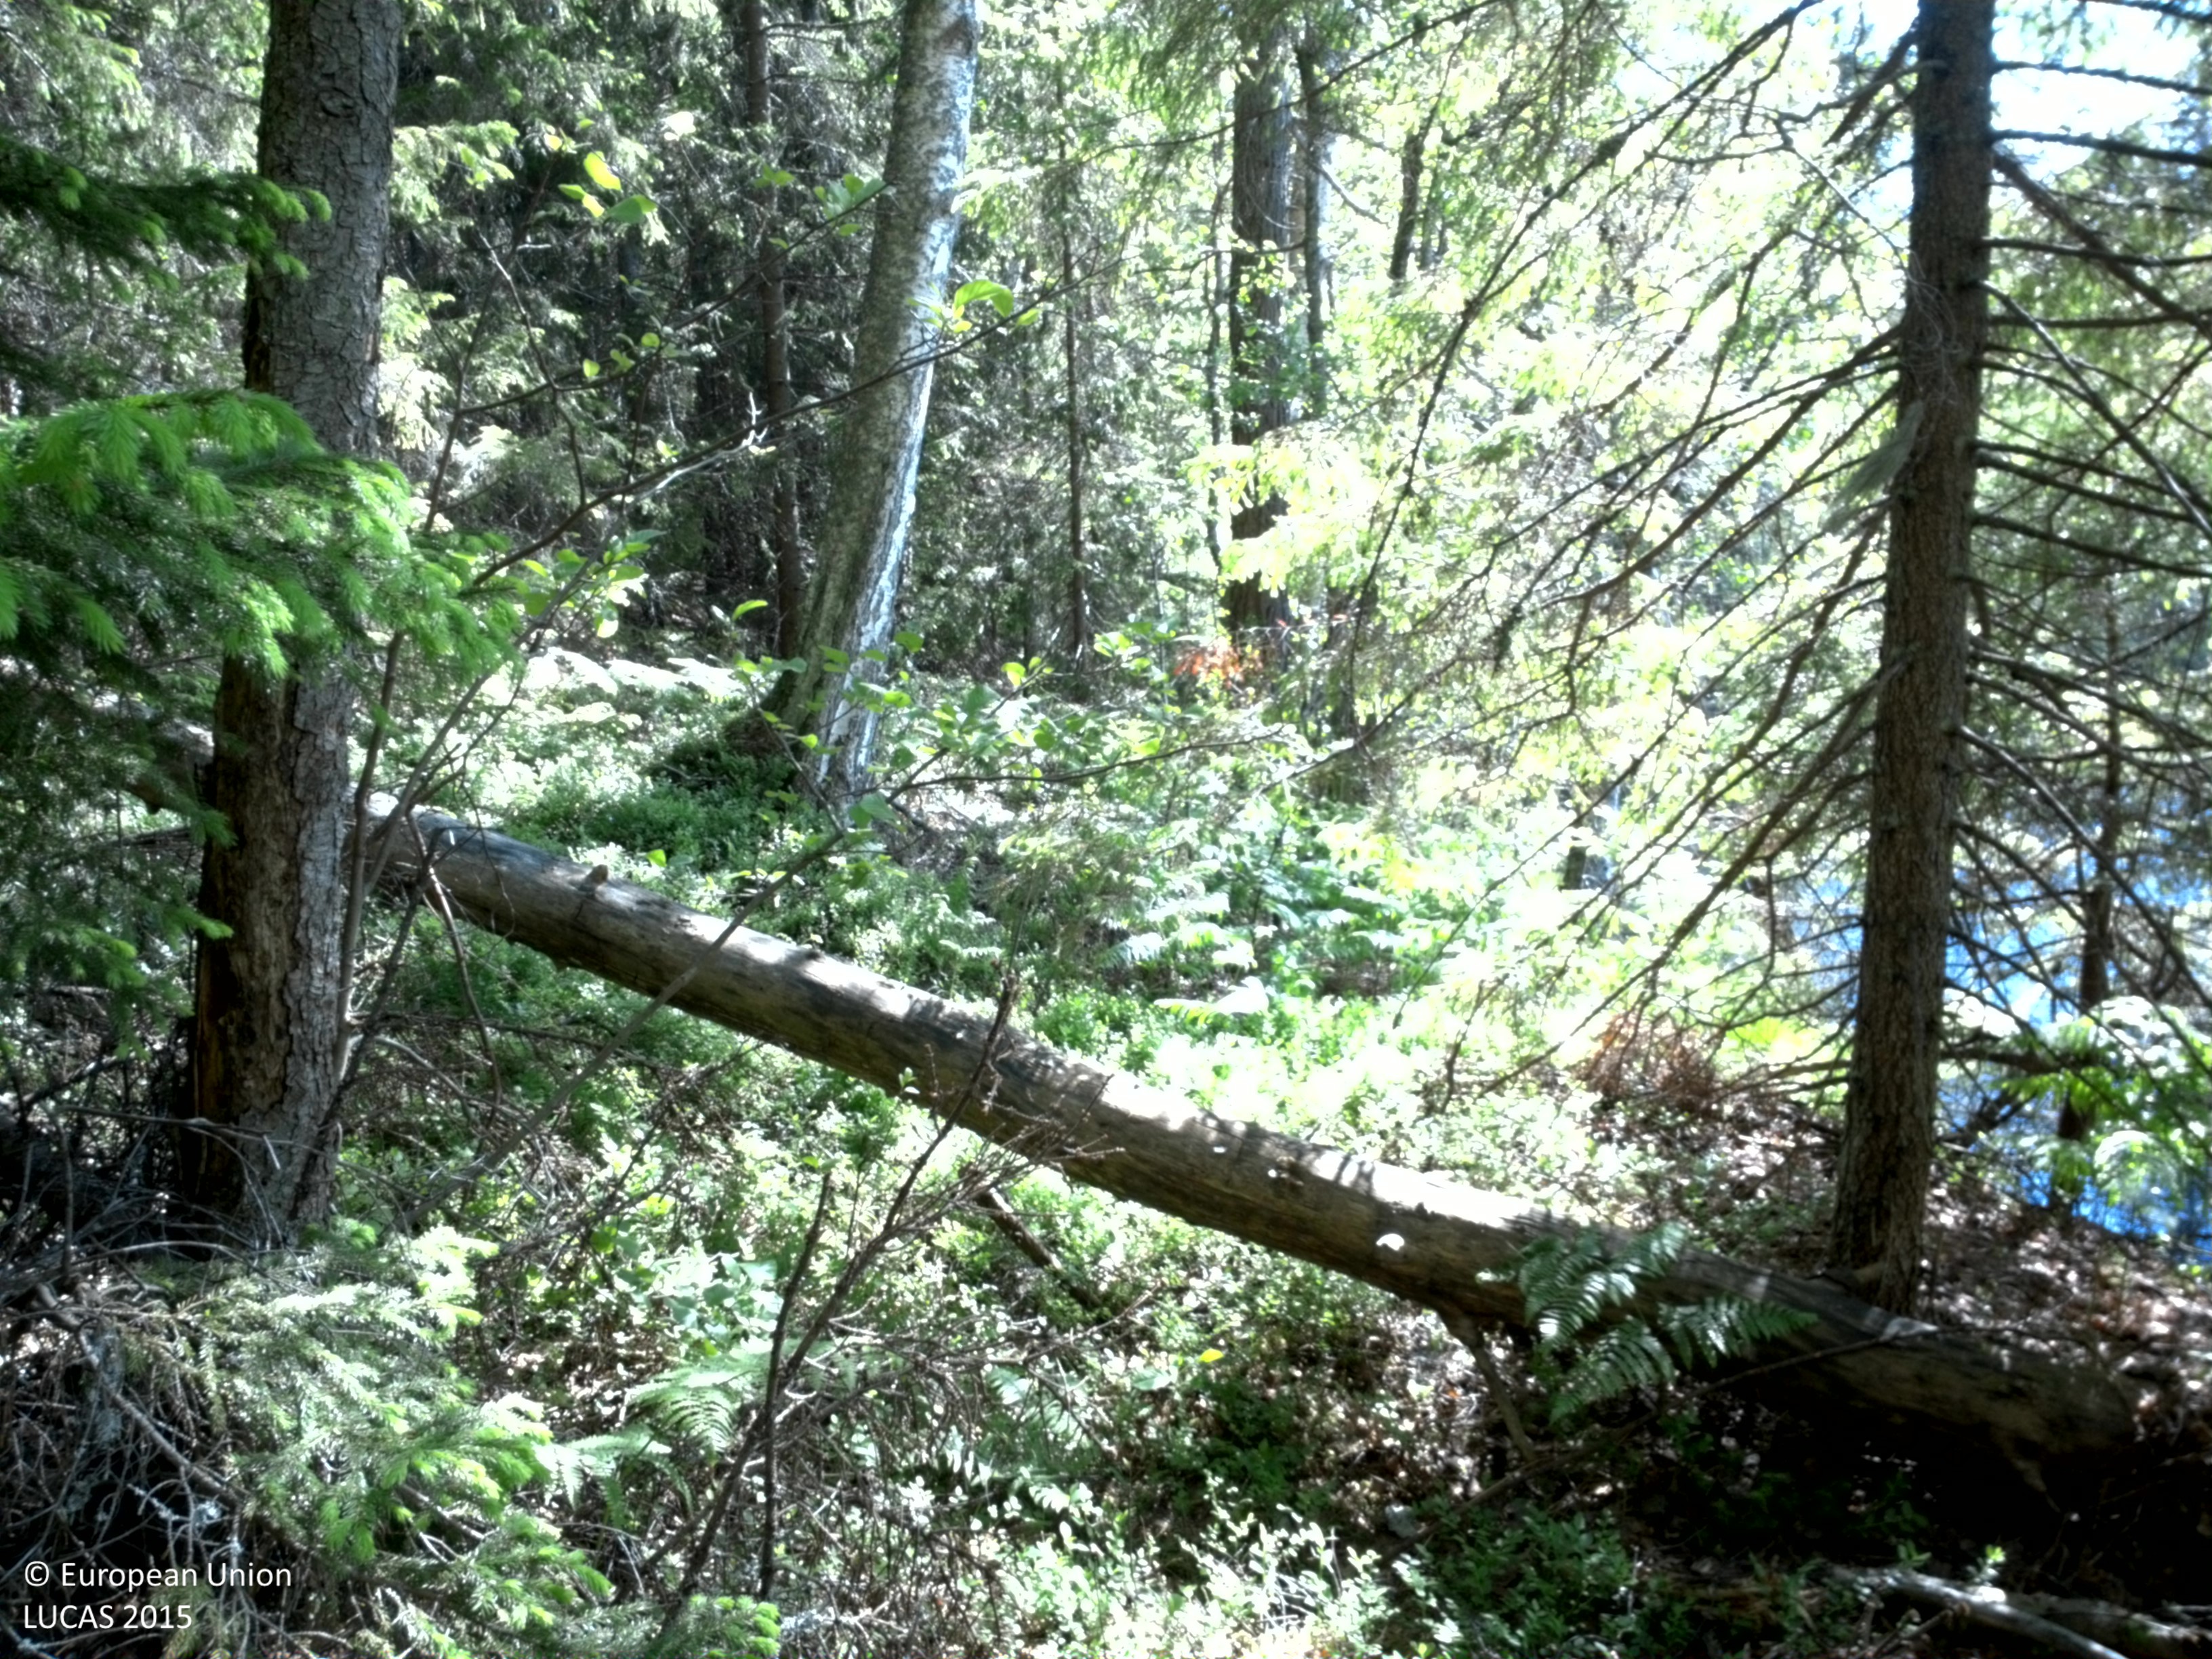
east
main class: Woodland
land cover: Spruce dominated mixed woodland
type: boreal forest
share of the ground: 25 - 50 %
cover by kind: herbaceous plants 40 %, coniferous forest trees 30 %, broadleaved forest trees 20 %, lichens and mosses 10 %
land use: Forestry
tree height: < 5 m
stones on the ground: < 10 %
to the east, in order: Spruce dominated mixed woodland; Ditches and canals; Spruce dominated mixed woodland; Tracks; Spruce dominated mixed woodland; Pine dominated mixed woodland; Spruce dominated coniferous woodland
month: June
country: SE
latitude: 58.6906
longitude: 16.1885
